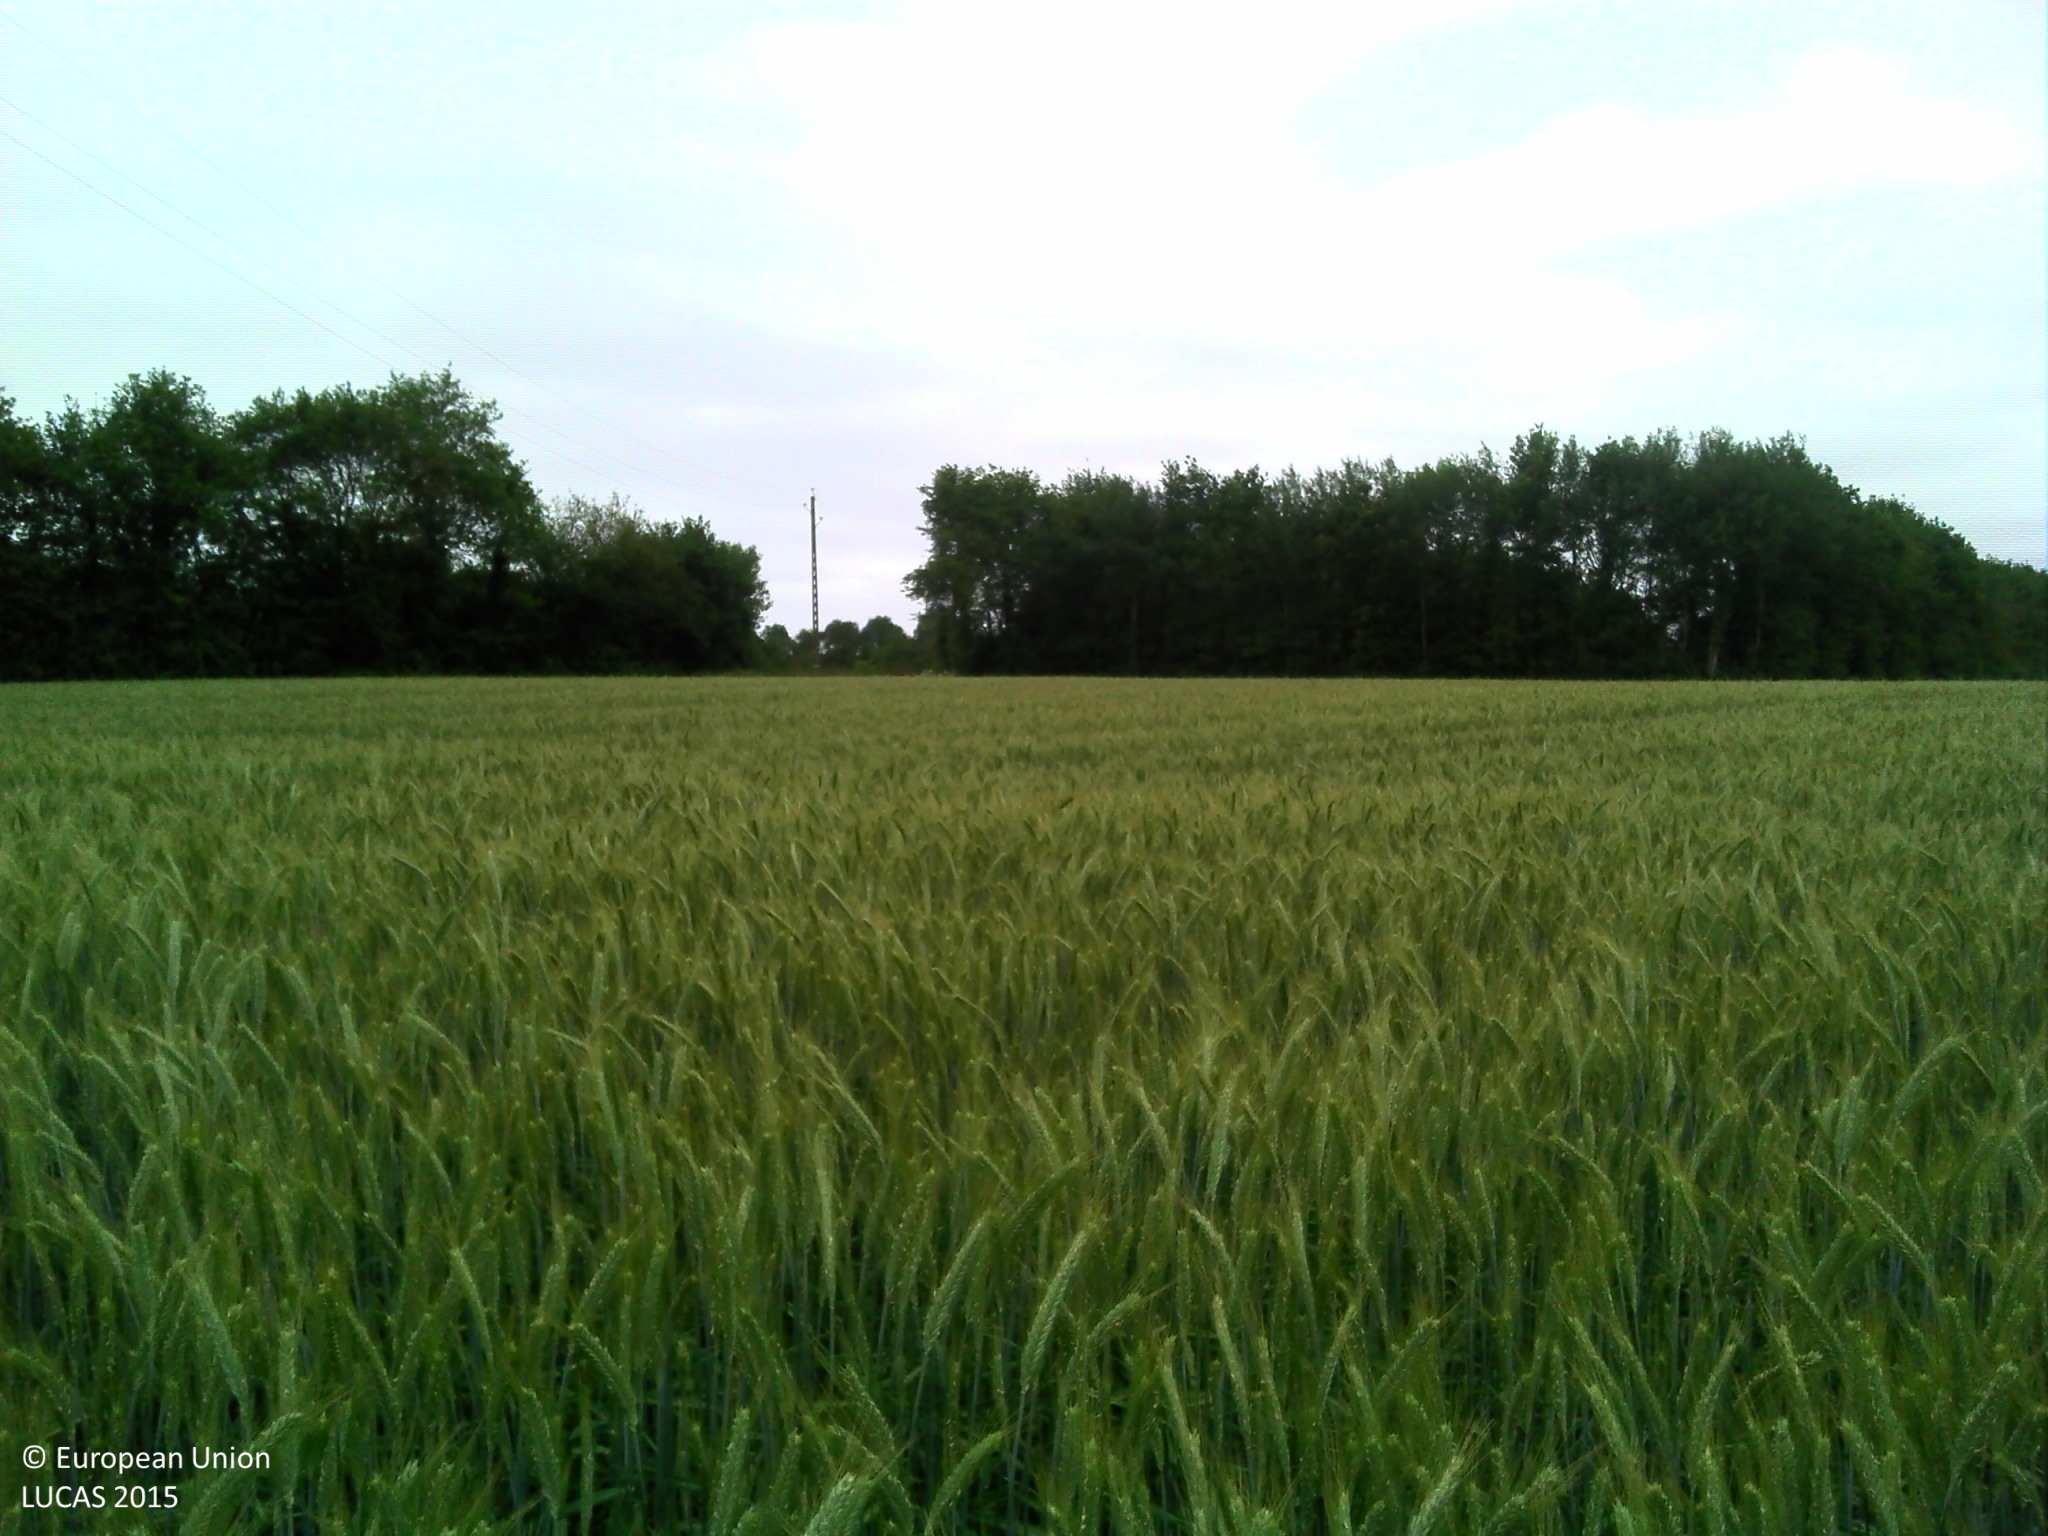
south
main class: Cropland
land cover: Triticale
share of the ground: > 75 %
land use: Agriculture (excluding fallow land and kitchen gardens)
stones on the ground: < 10 %
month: June
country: FR
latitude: 46.8794
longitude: -1.7874
